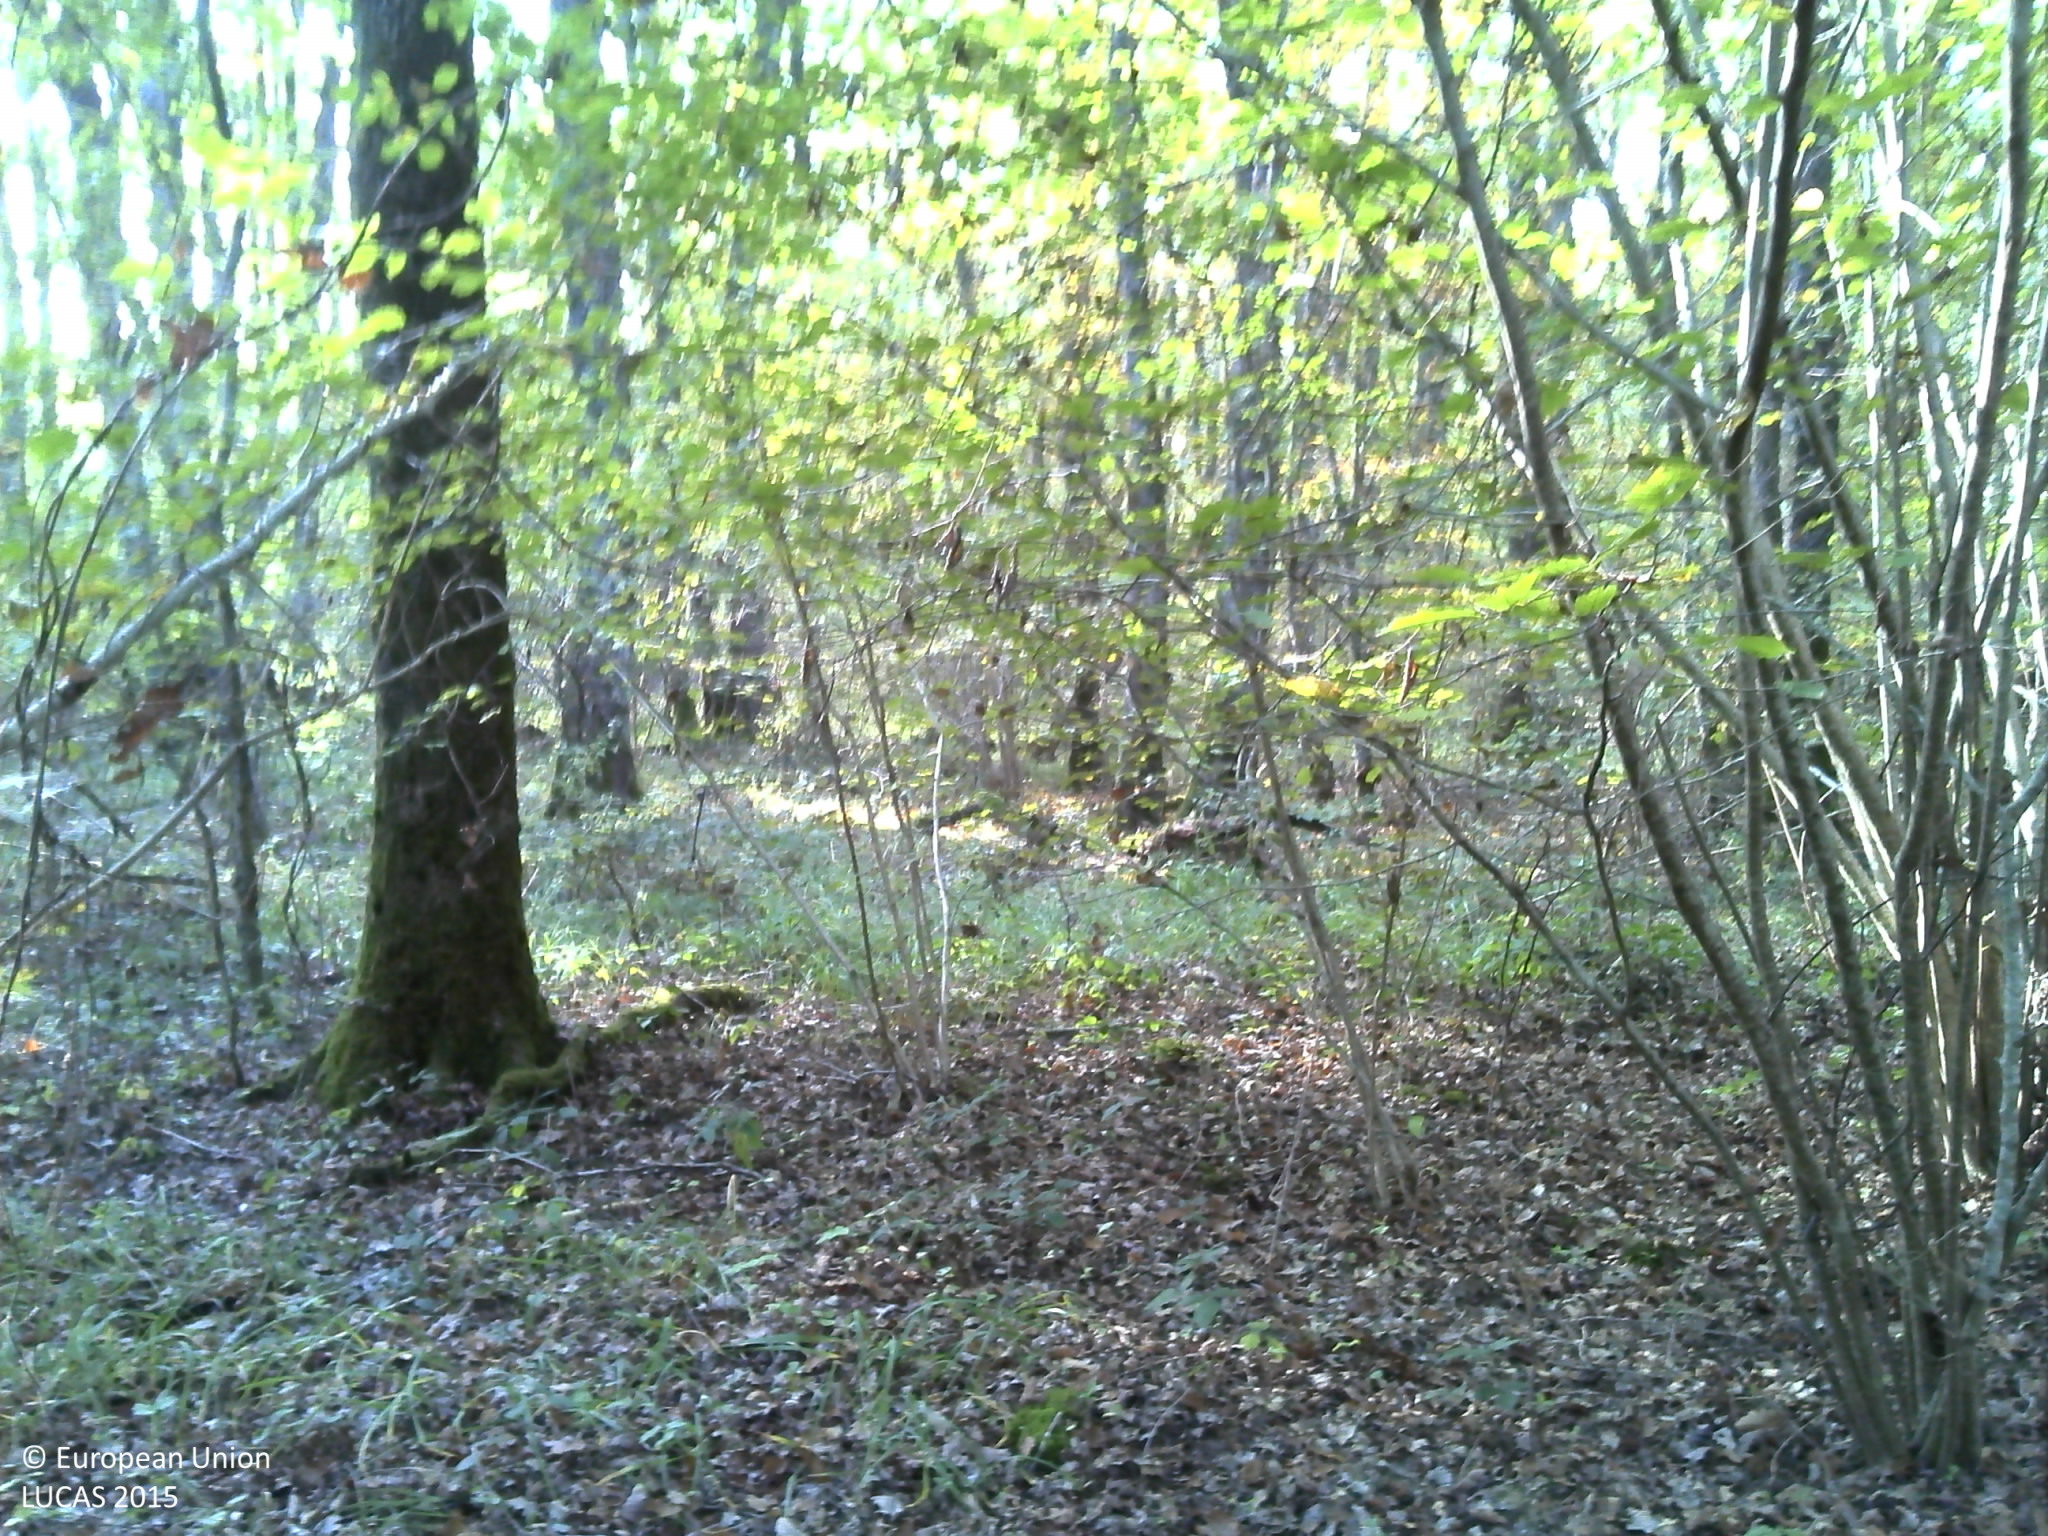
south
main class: Woodland
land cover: Broadleaved woodland
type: mesophytic deciduous forest
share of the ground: > 75 %
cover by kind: broadleaved forest trees 90 %, herbaceous plants 5 %, unconsolidated bare surface 5 %
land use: Forestry
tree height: > 5 m
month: October
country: FR
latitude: 46.2800
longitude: 6.0969
